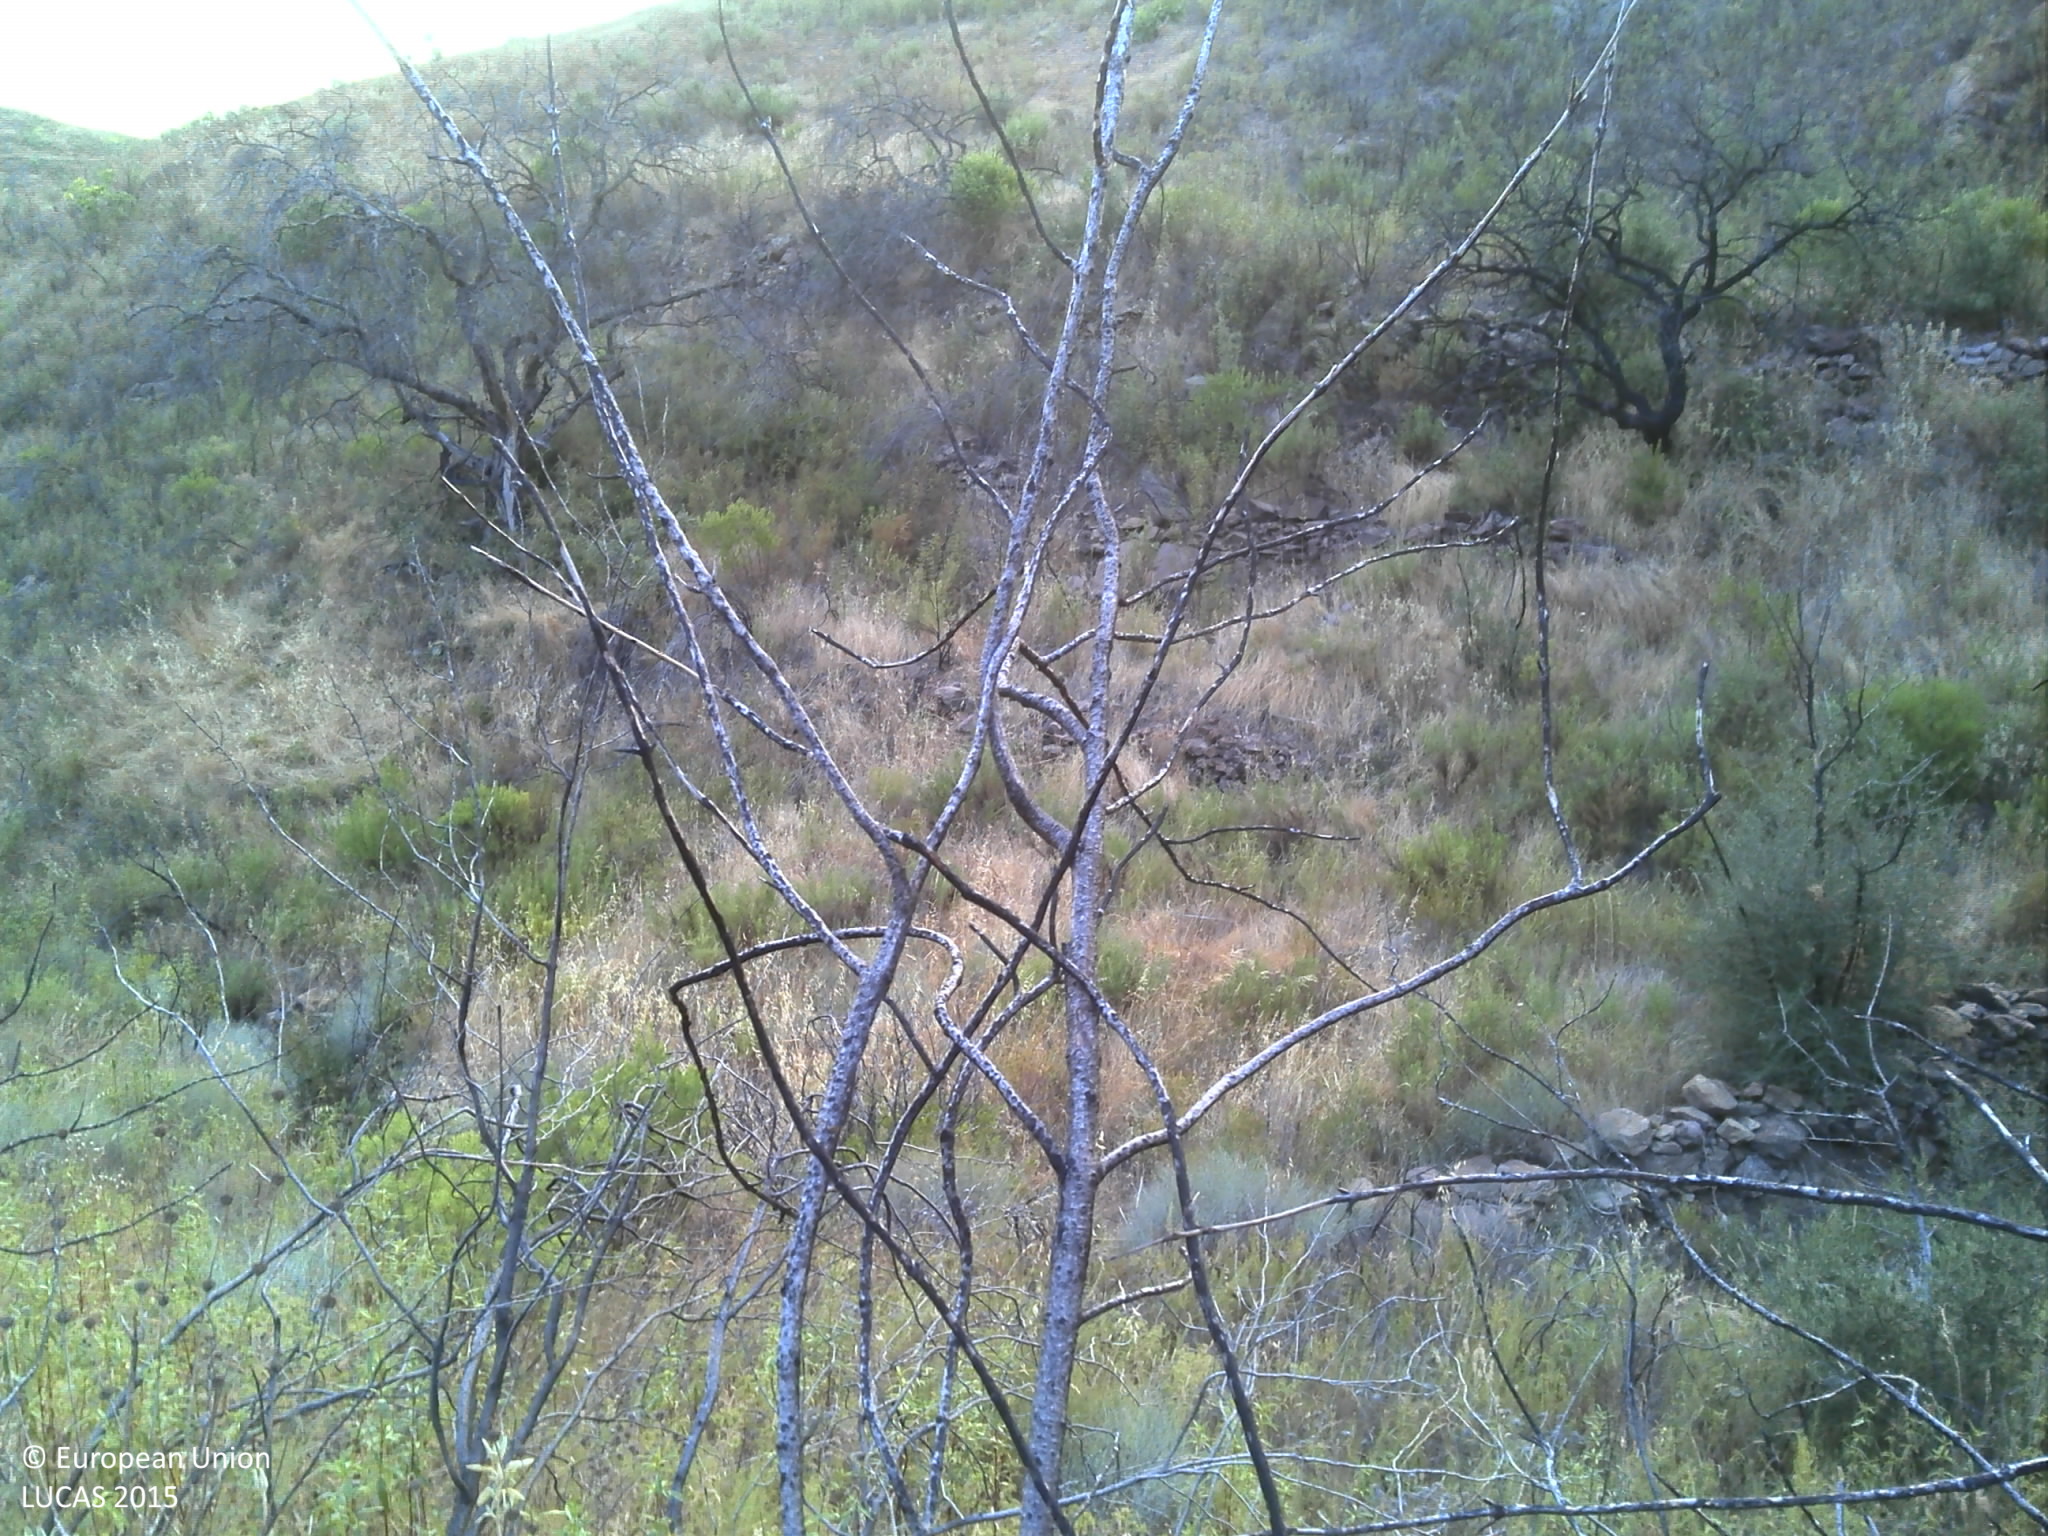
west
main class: Shrubland
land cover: Shrubland without tree cover
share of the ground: 50 - 75 %
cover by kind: shrubs 75 %, unconsolidated bare surface 15 %, herbaceous plants 10 %
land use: Abandoned areas
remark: Burnt area
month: June
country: PT
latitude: 37.1868
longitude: -7.6809
